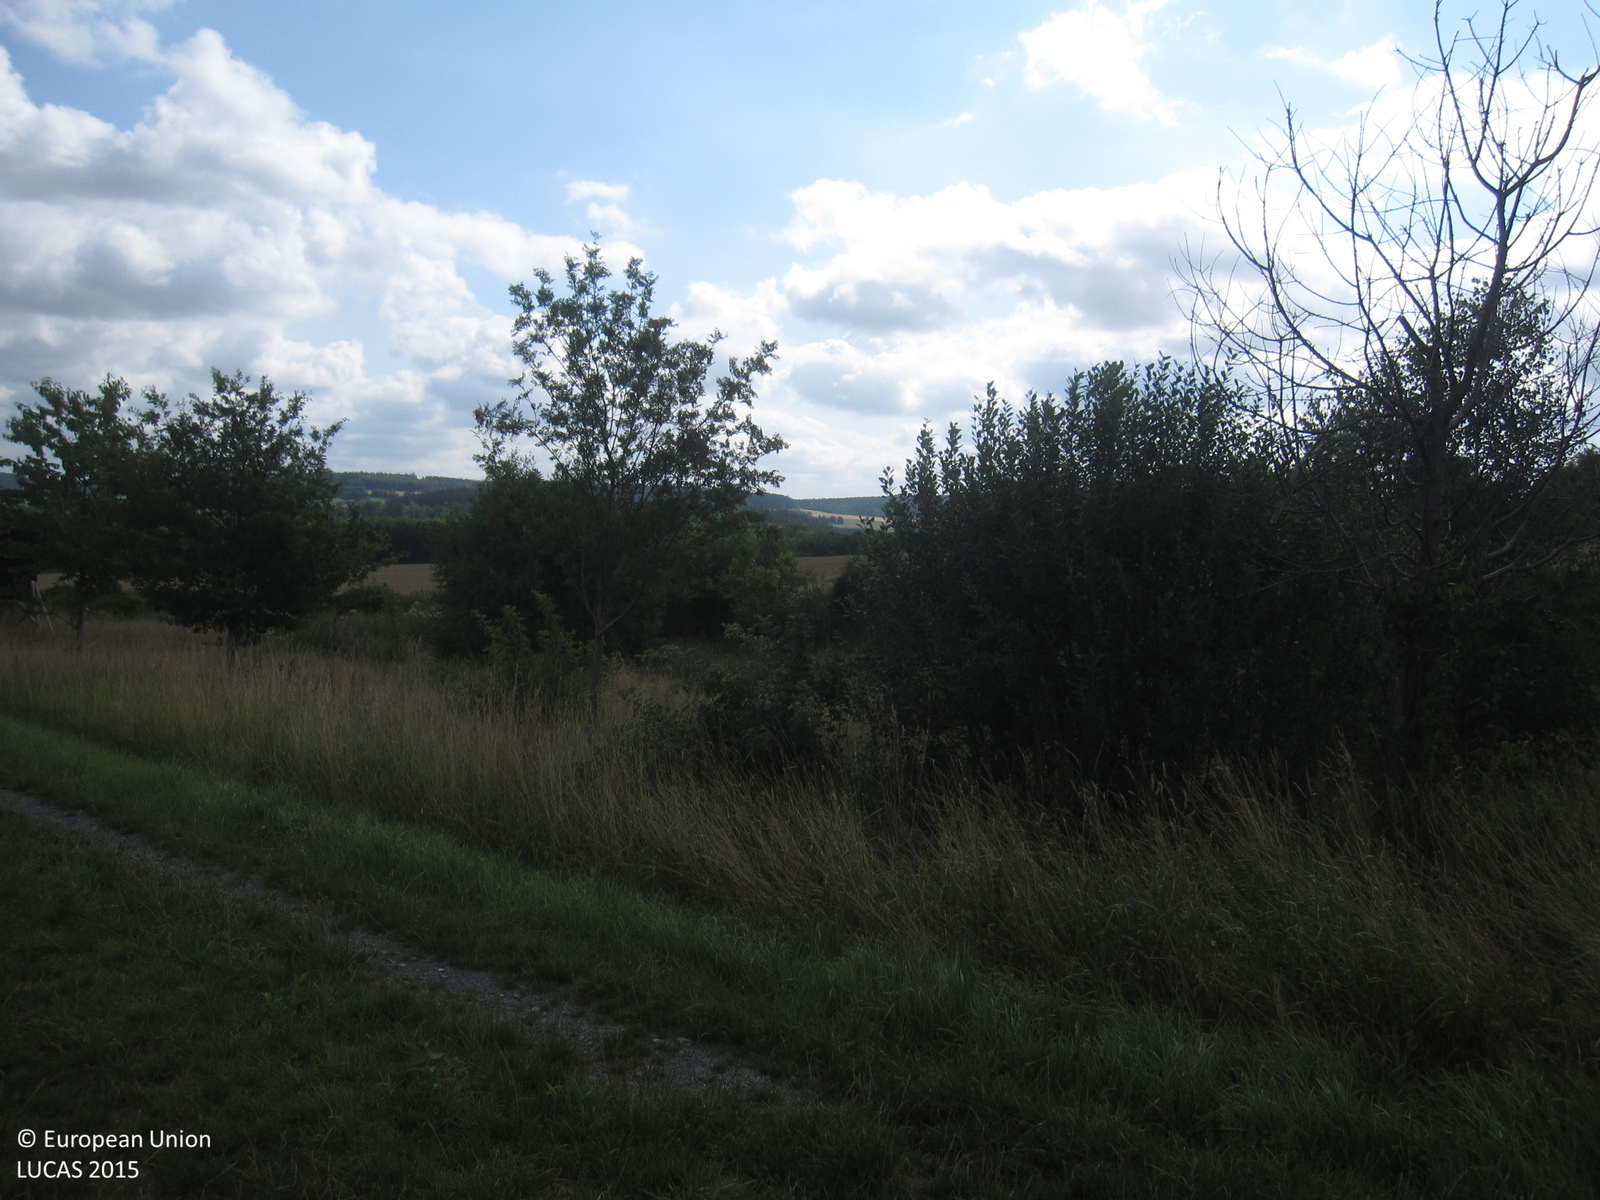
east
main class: Cropland
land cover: Rye
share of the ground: > 75 %
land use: Agriculture (excluding fallow land and kitchen gardens)
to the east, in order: Rye; Fences; Abandoned hedges; Tracks; Broadleaved woodland; Oats; Barley
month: July
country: DE
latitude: 50.3819
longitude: 12.0388
